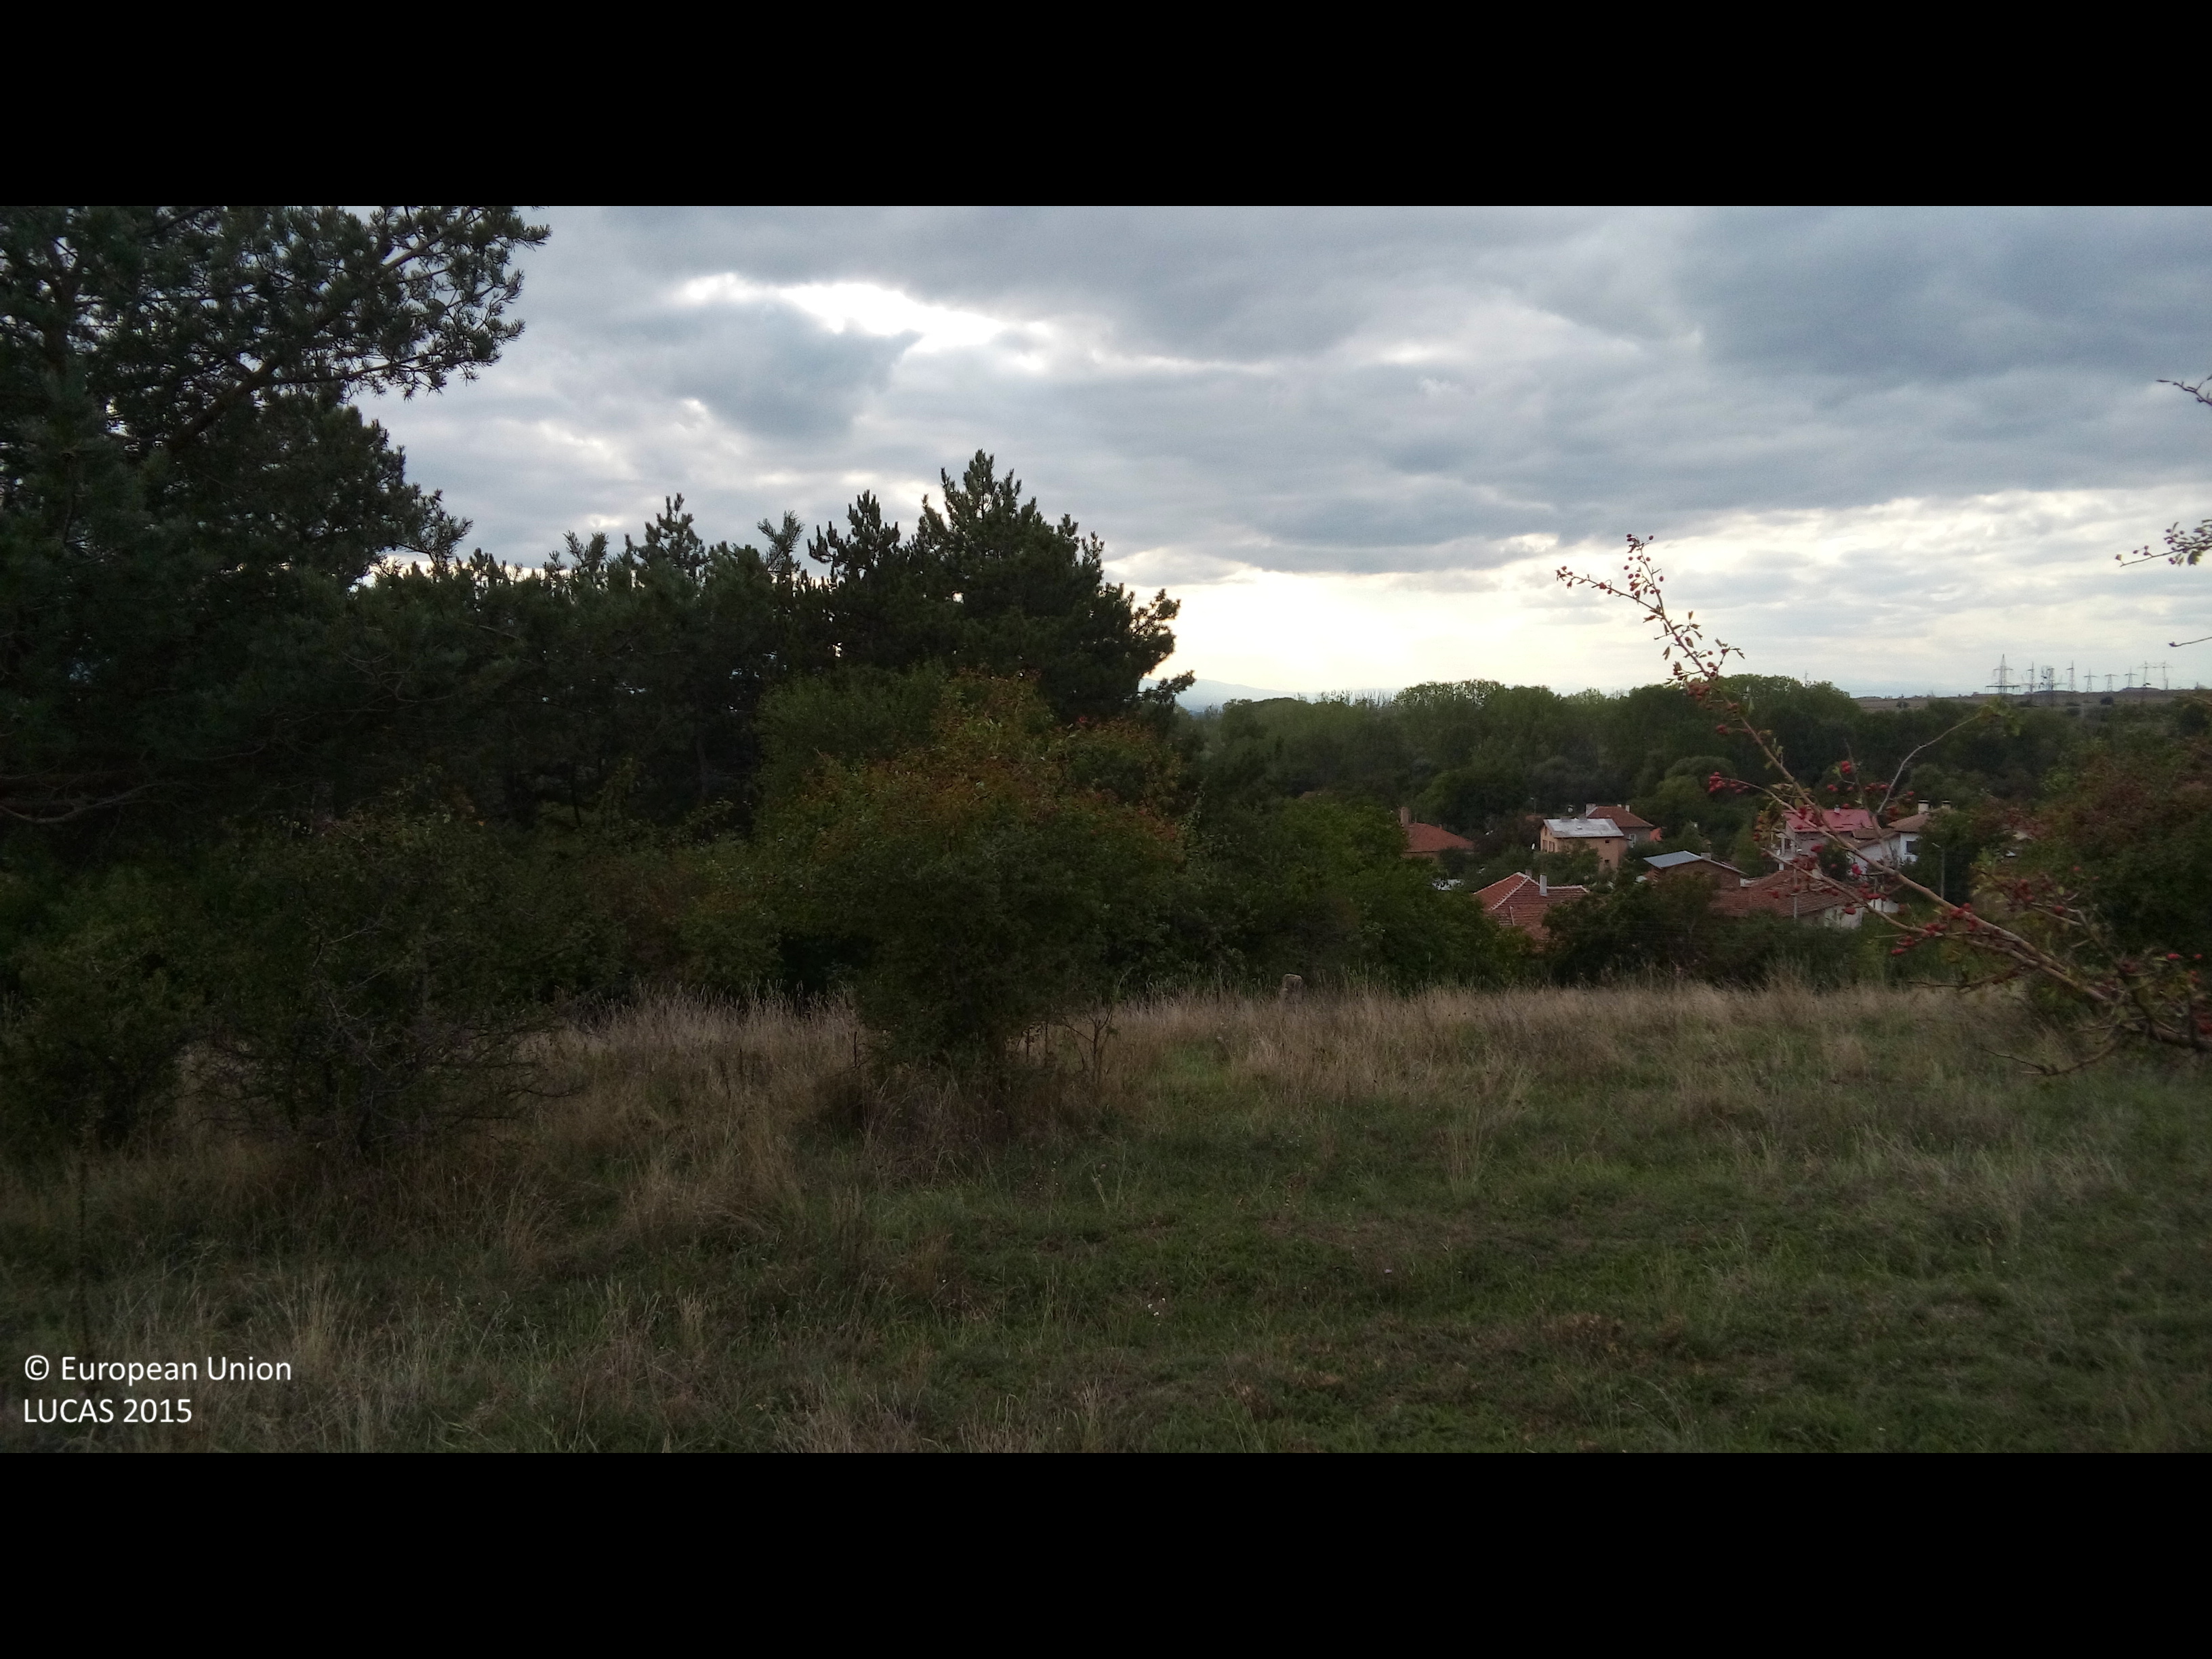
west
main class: Grassland
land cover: Grassland with sparse tree/shrub cover
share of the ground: 50 - 75 %
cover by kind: herbaceous plants 65 %, unconsolidated bare surface 30 %, broadleaved forest trees 5 %
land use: Agriculture (excluding fallow land and kitchen gardens)
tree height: > 5 m
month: October
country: BG
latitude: 42.7154
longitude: 23.6293
